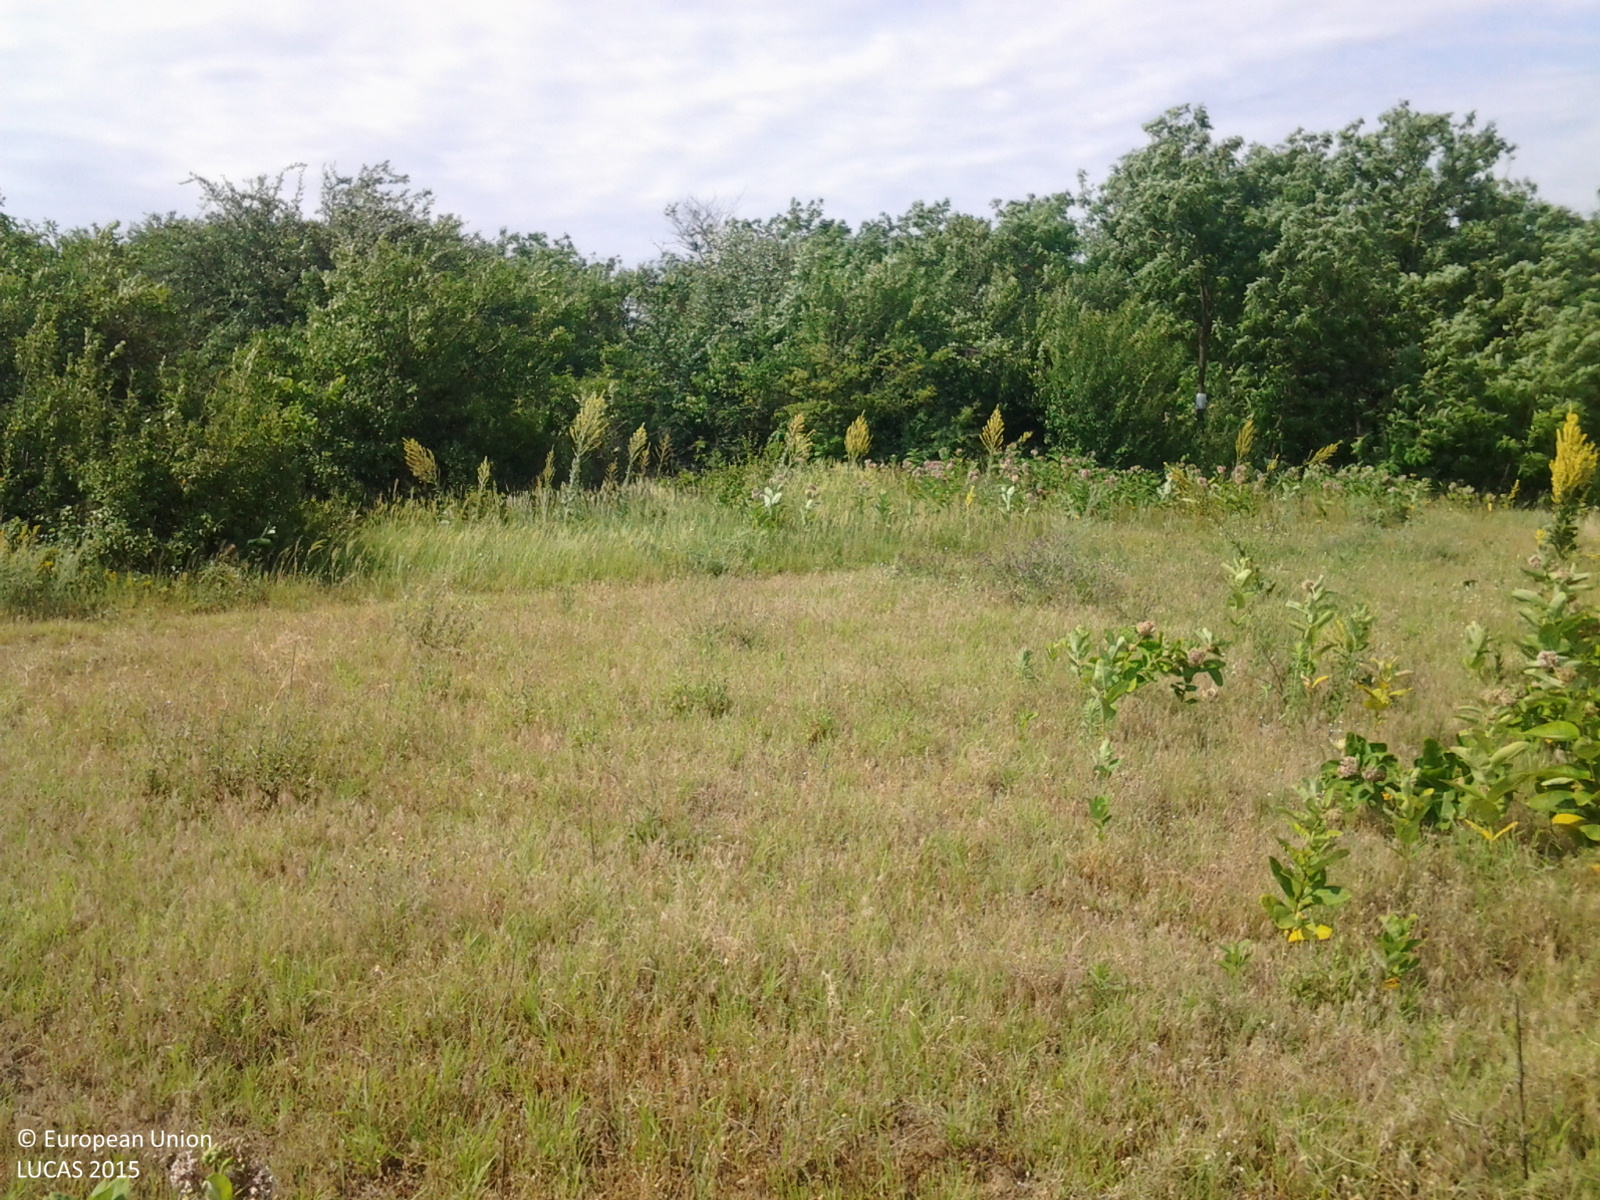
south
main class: Grassland
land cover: Spontaneously vegetated surfaces
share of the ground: > 75 %
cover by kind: herbaceous plants 100 %
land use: Fallow land
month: June
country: HU
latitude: 46.3748
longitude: 19.1536
